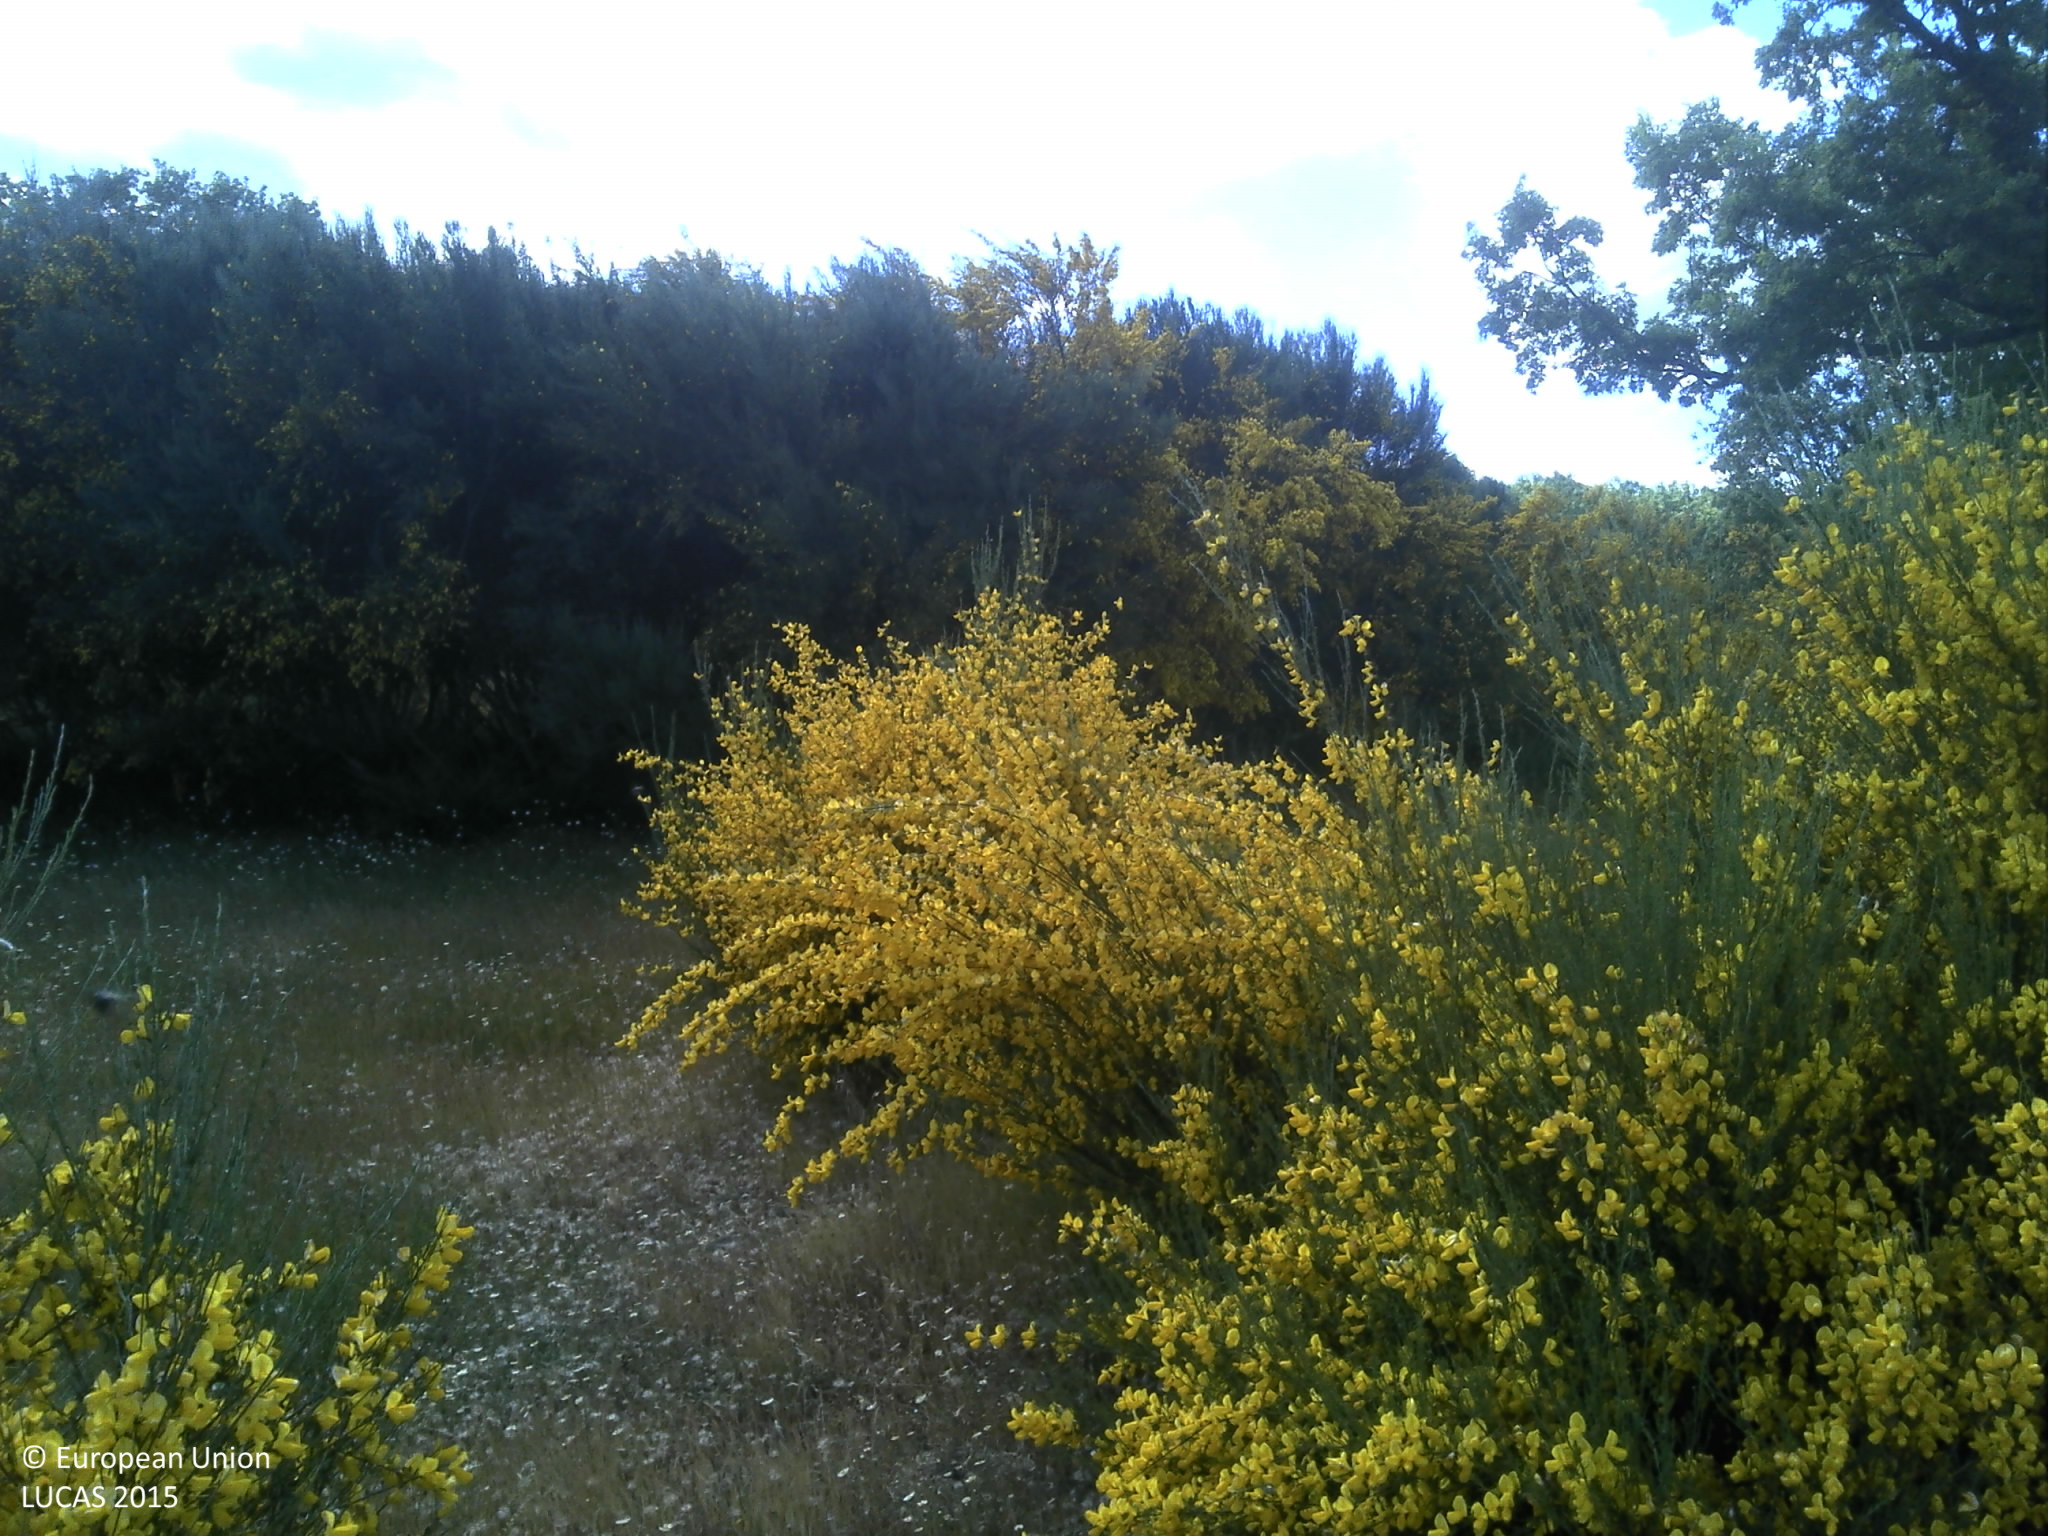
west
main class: Grassland
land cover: Grassland with sparse tree/shrub cover
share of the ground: 50 - 75 %
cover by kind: herbaceous plants 70 %, unconsolidated bare surface 20 %, broadleaved forest trees 5 %, shrubs 5 %
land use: Agriculture (excluding fallow land and kitchen gardens)
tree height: > 5 m
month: May
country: PT
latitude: 40.5366
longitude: -7.2358
